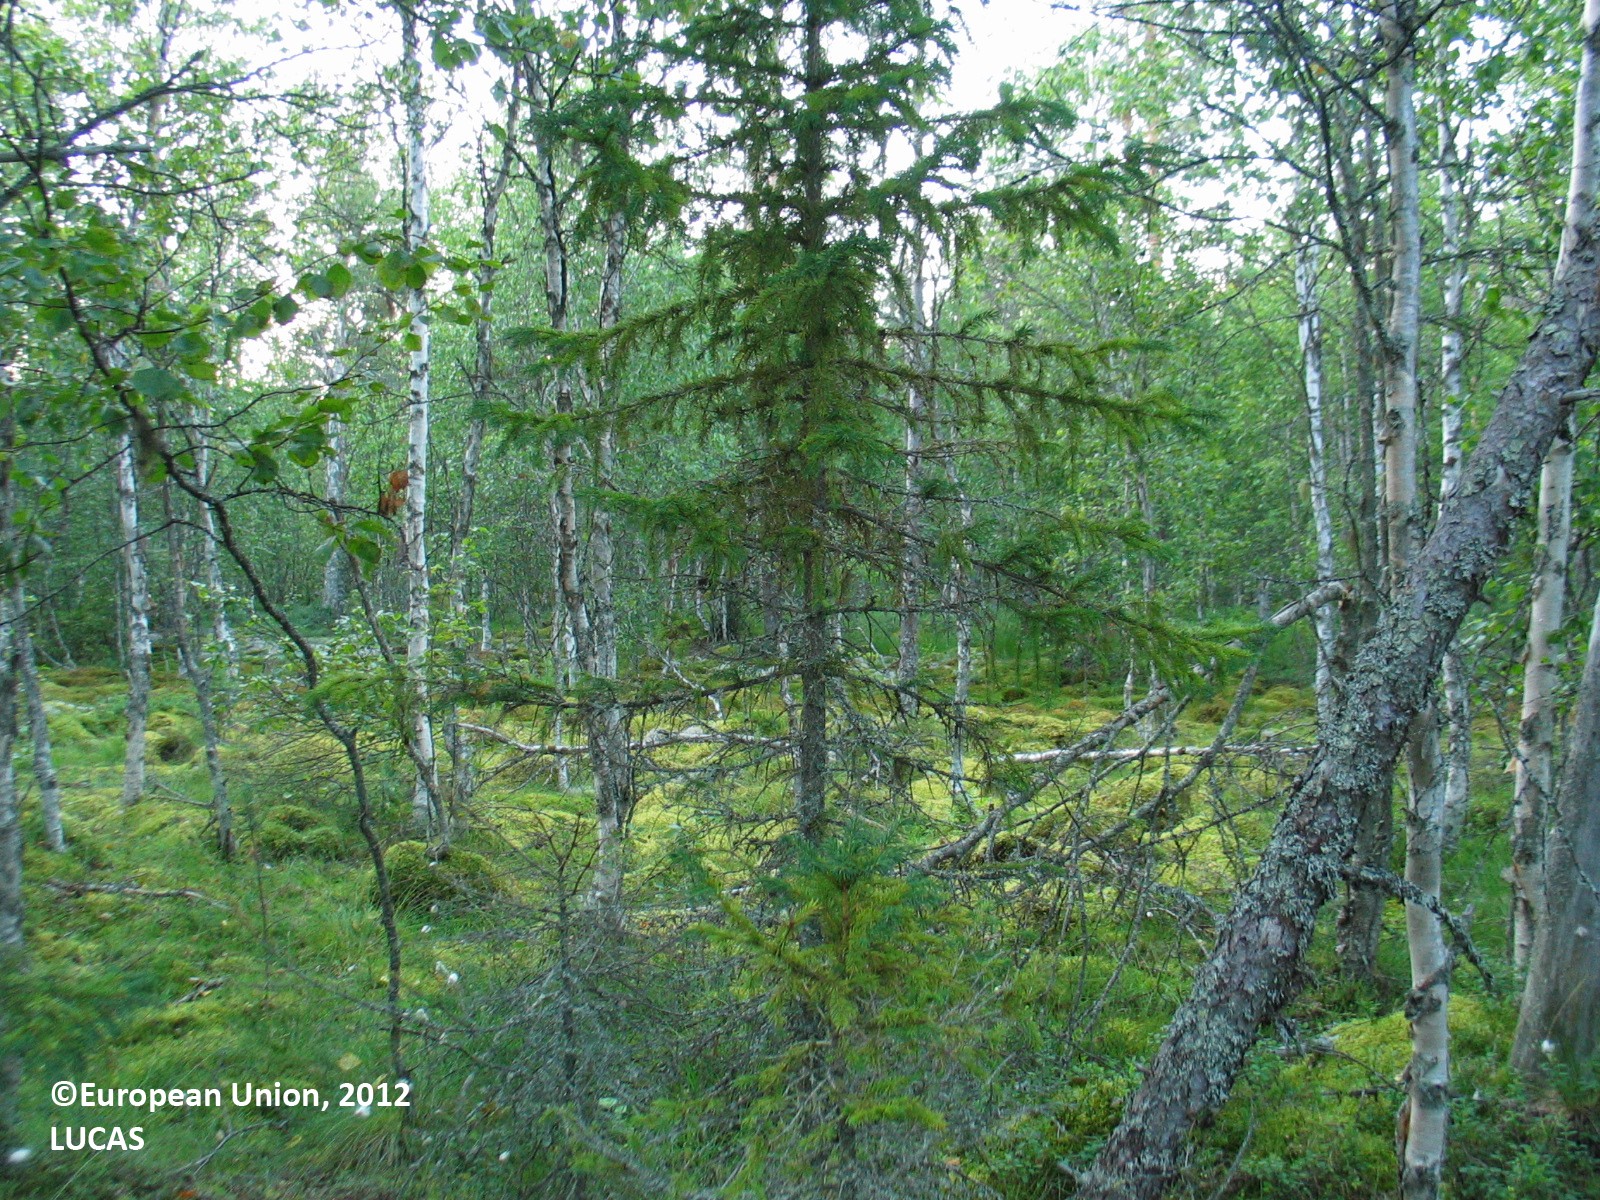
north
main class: Woodland
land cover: Other mixed woodland
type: mire and swamp forests
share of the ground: 50 - 75 %
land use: Semi-natural and natural areas not in use
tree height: > 5 m
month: July
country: FI
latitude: 64.6125
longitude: 26.5667
